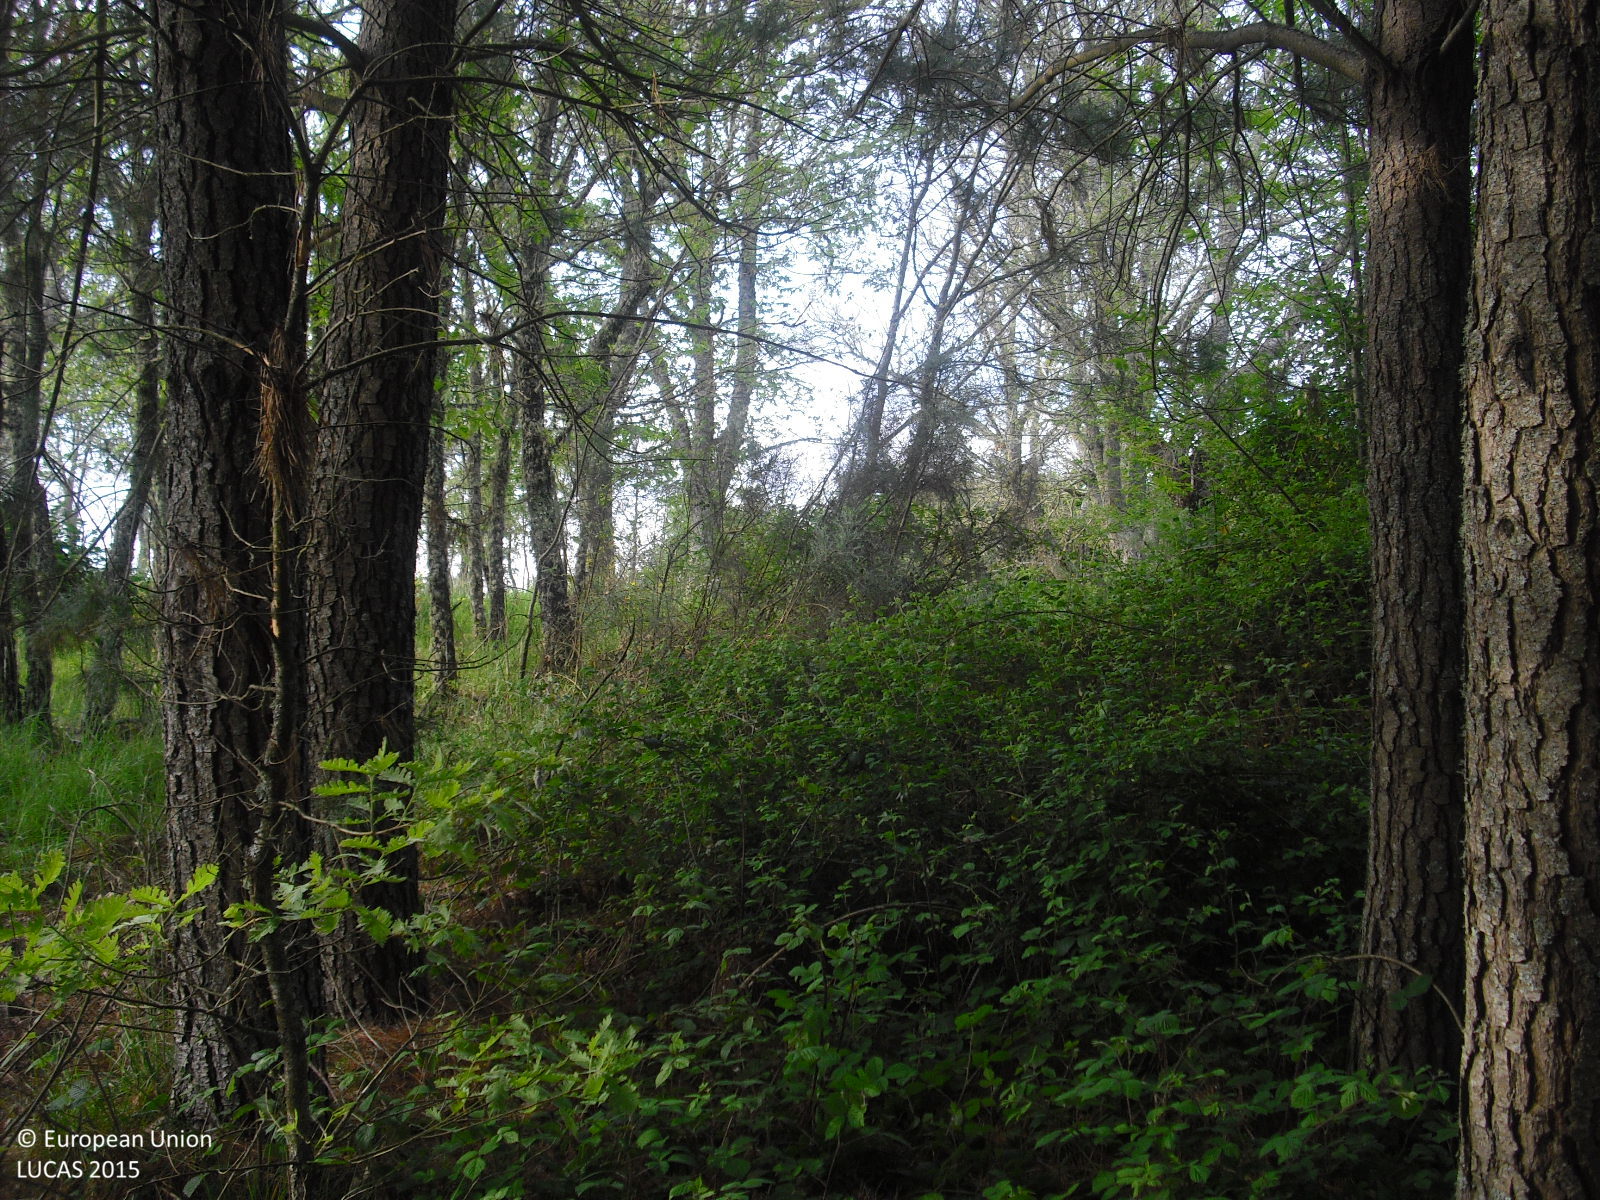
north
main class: Woodland
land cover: Pine dominated coniferous woodland
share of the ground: > 75 %
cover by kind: coniferous forest trees 100 %
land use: Forestry
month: May
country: ES
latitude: 41.9455
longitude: -7.2936
